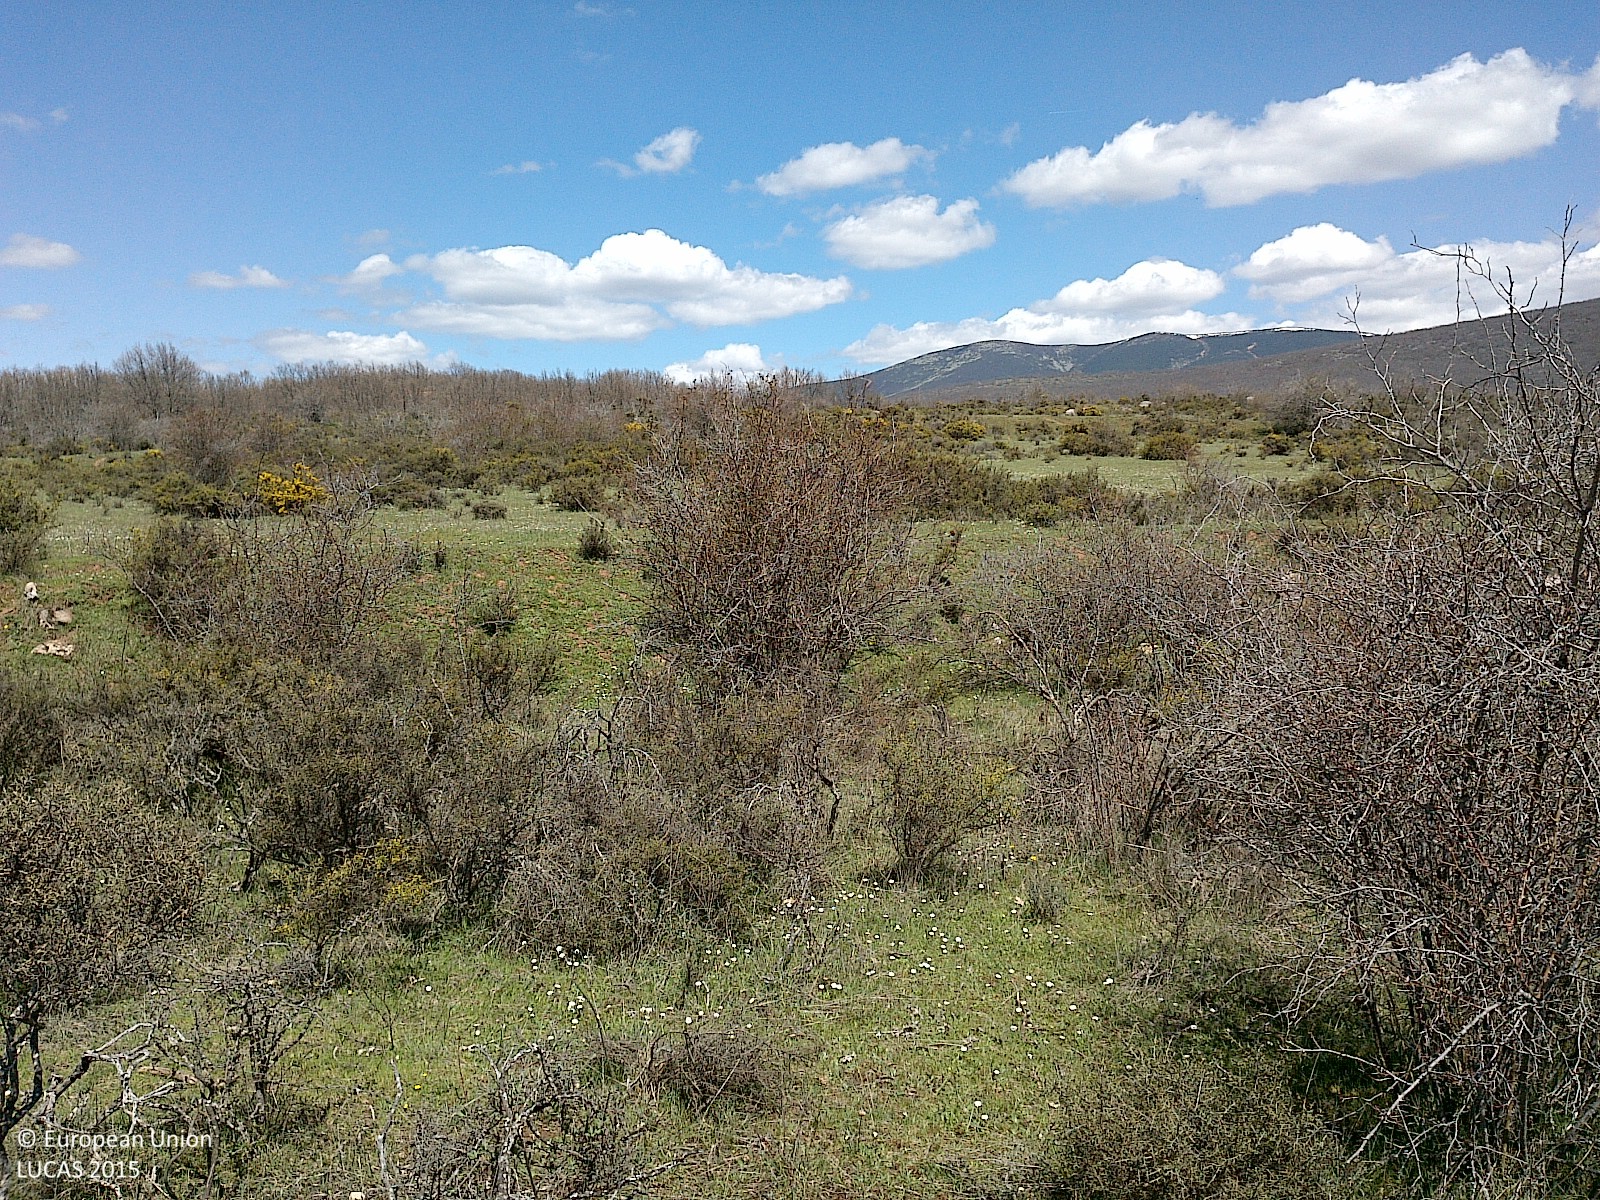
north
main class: Shrubland
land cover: Shrubland without tree cover
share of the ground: 50 - 75 %
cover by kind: shrubs 55 %, herbaceous plants 45 %
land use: Agriculture (excluding fallow land and kitchen gardens)
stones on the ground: < 10 %
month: April
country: ES
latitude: 42.1171
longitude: -3.3208
